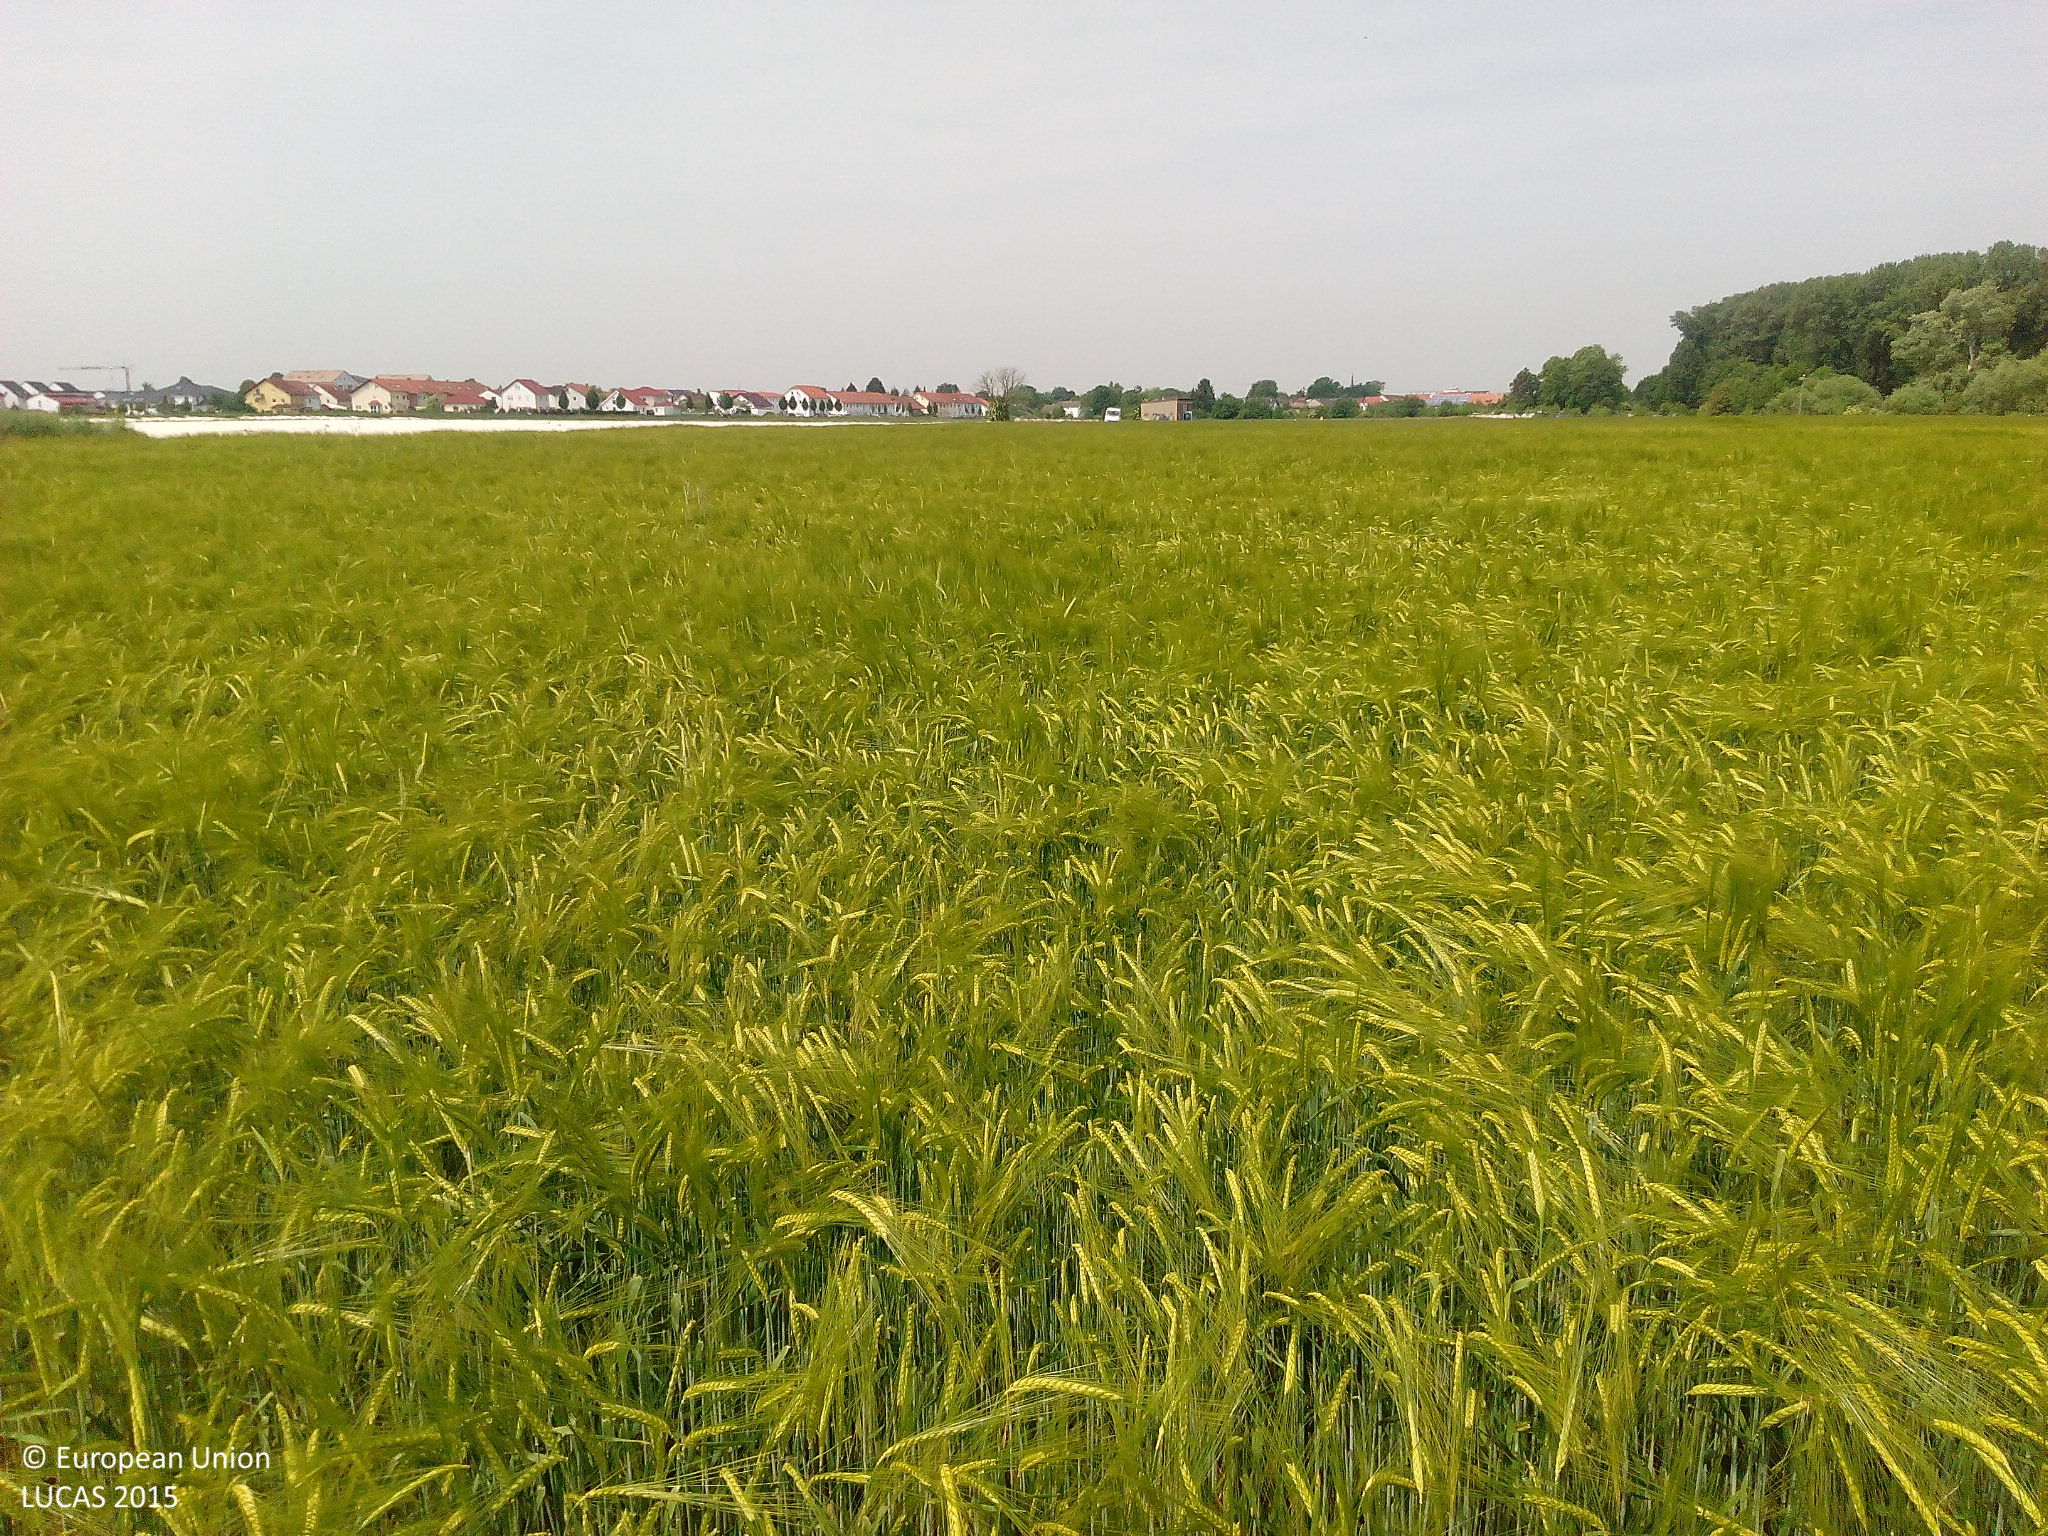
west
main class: Cropland
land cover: Barley
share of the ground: > 75 %
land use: Agriculture (excluding fallow land and kitchen gardens)
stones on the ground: < 10 %
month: May
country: DE
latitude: 49.8328
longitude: 8.5128
